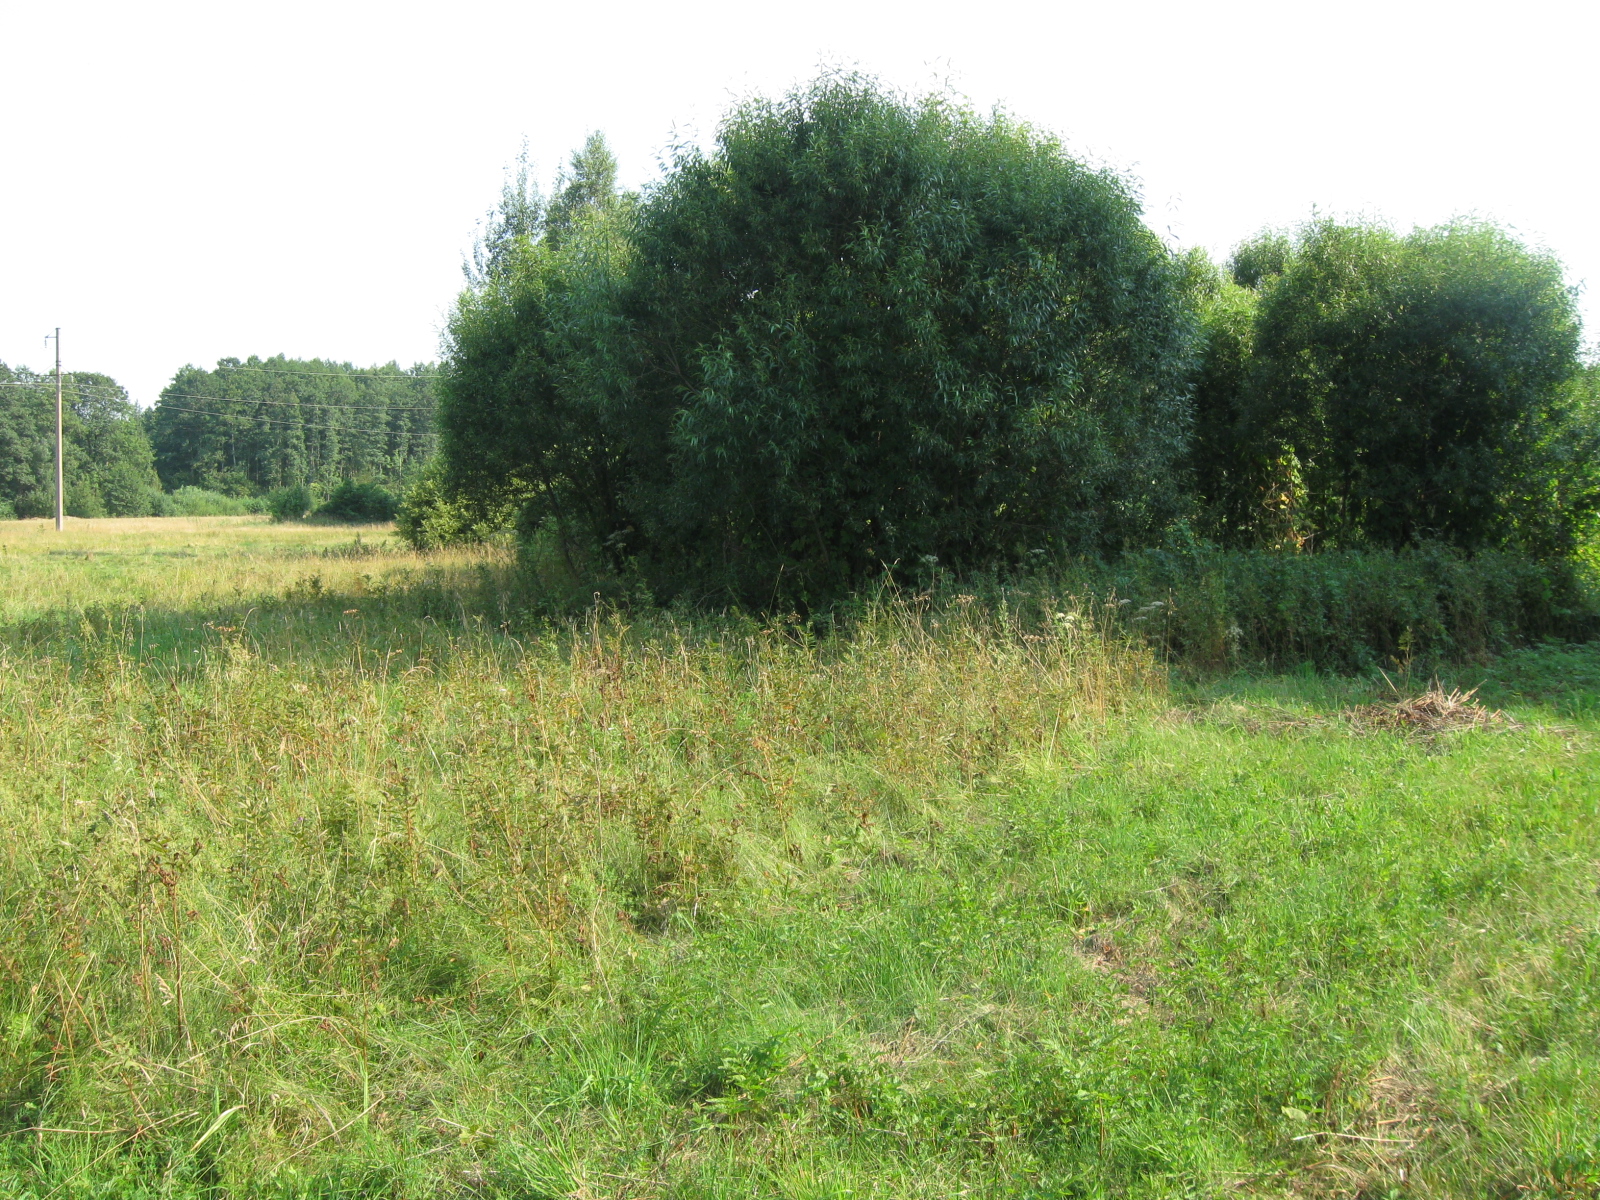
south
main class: Grassland
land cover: Grassland without tree/shrub cover
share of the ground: > 75 %
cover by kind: herbaceous plants 90 %, unconsolidated bare surface 10 %
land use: Agriculture (excluding fallow land and kitchen gardens)
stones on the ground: < 10 %
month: August
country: LT
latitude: 54.7369
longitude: 23.3580
